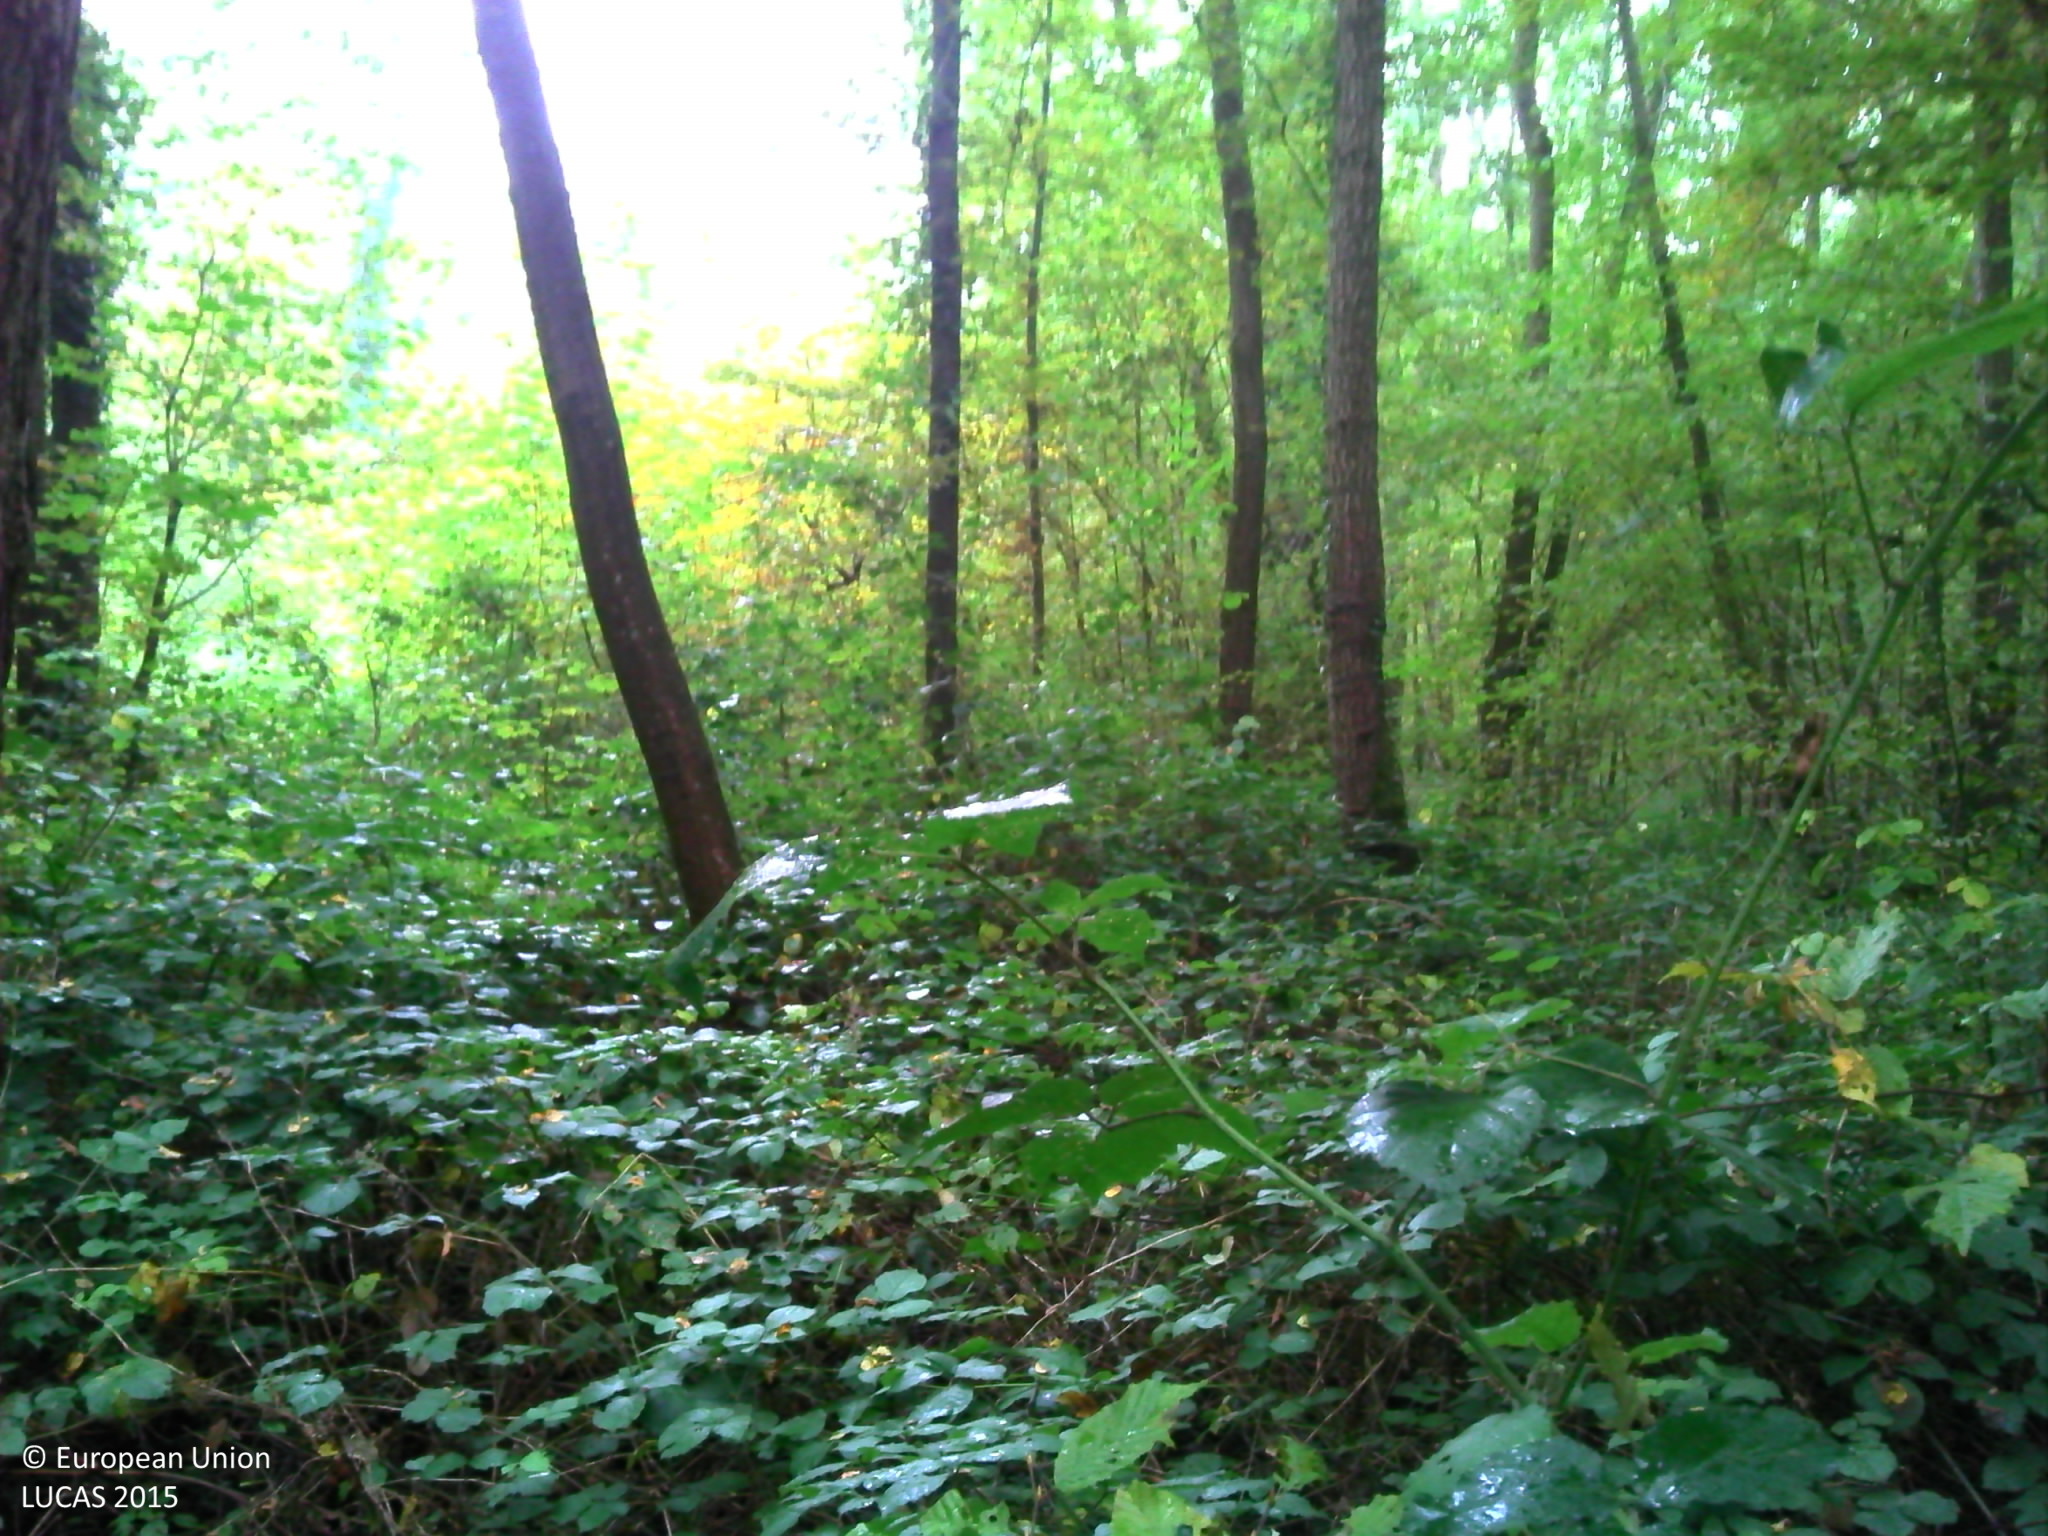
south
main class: Woodland
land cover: Broadleaved woodland
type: mesophytic deciduous forest
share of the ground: > 75 %
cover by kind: broadleaved forest trees 80 %, shrubs 15 %, herbaceous plants 5 %
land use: Forestry
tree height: > 5 m
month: October
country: FR
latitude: 49.5891
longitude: 3.2827
